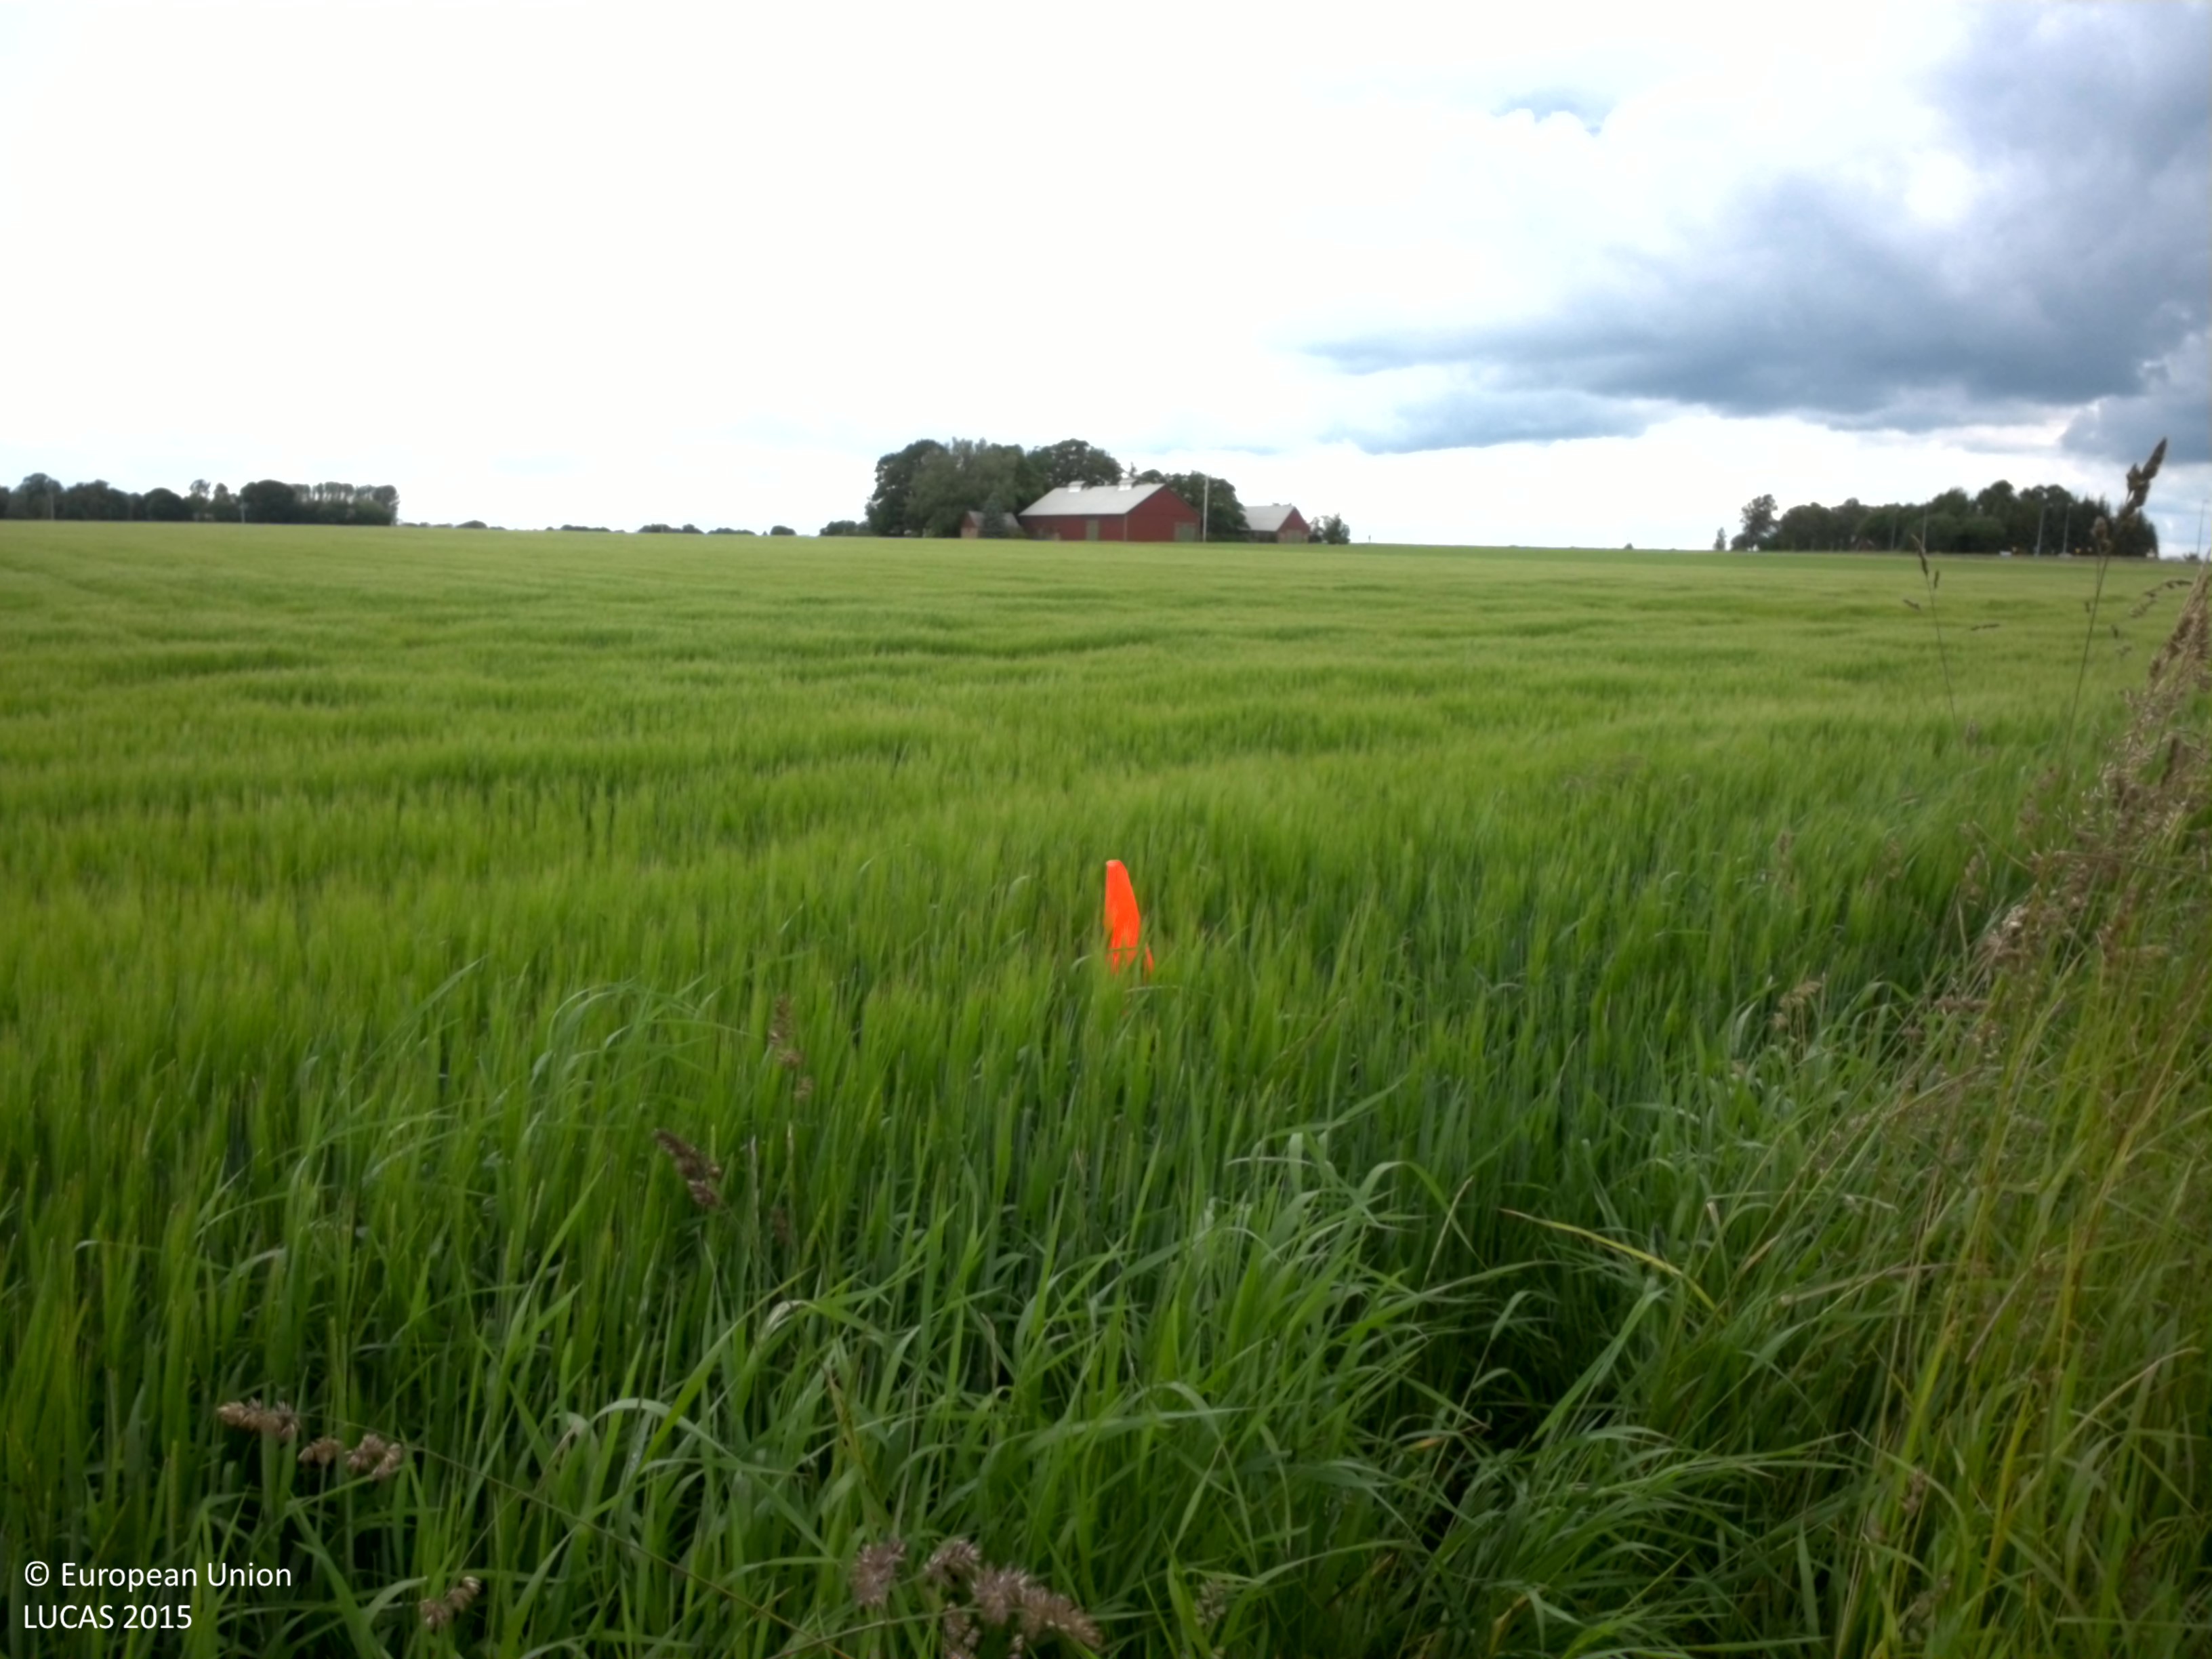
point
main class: Cropland
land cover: Barley
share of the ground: > 75 %
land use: Agriculture (excluding fallow land and kitchen gardens)
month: June
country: SE
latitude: 55.7201
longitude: 13.0386
